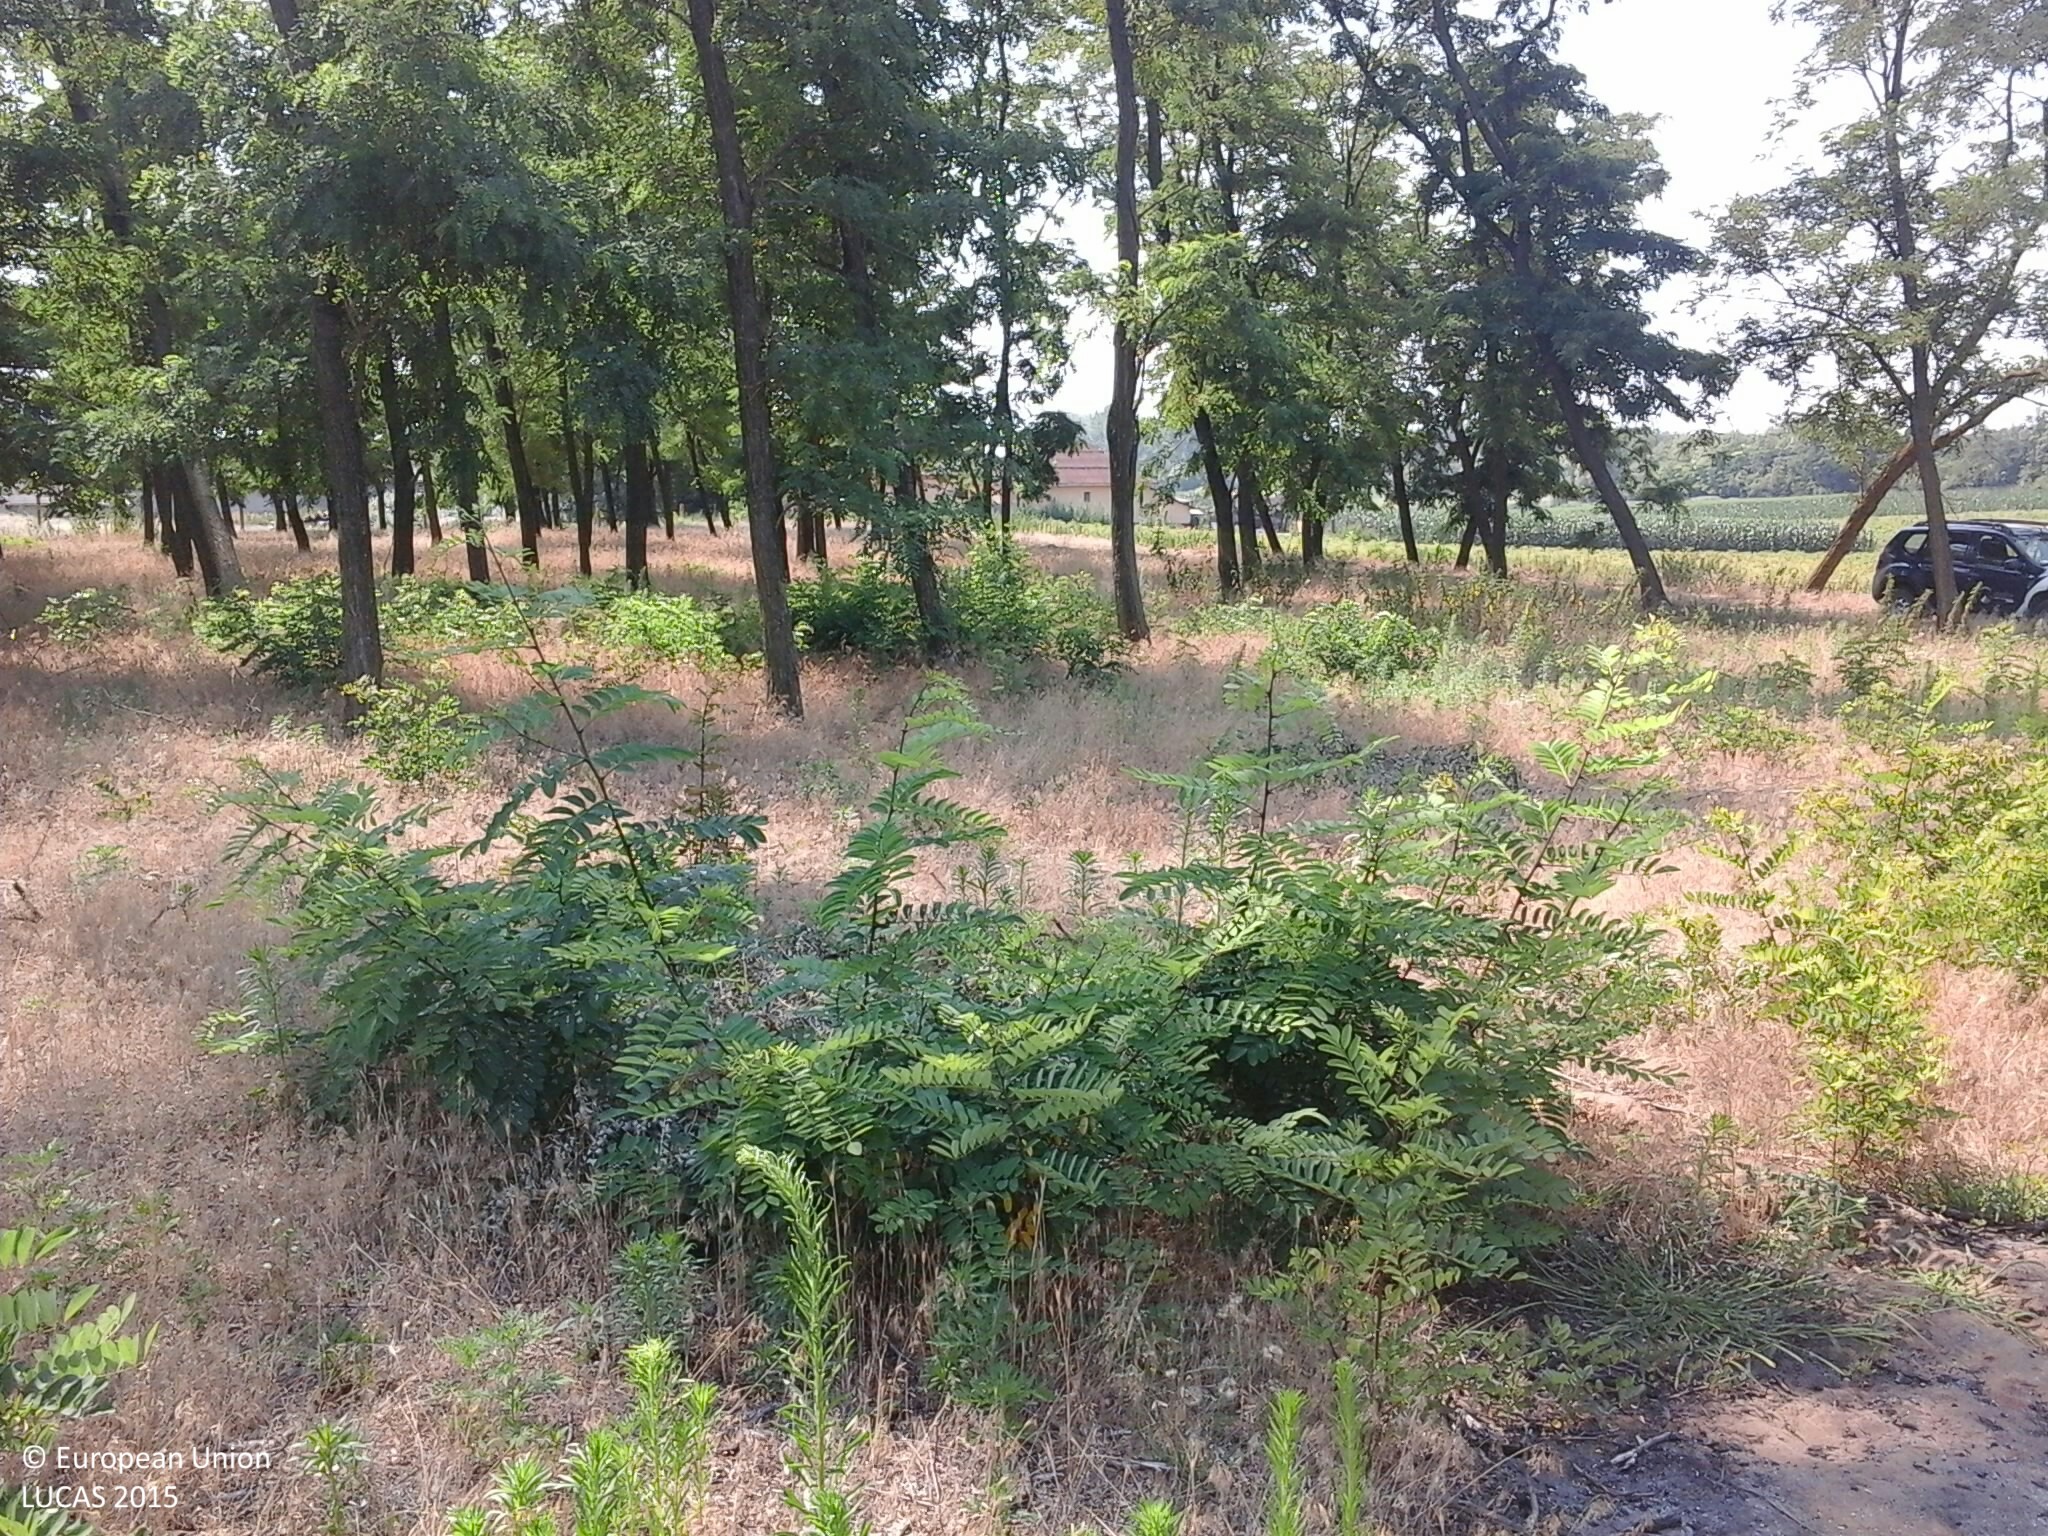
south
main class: Woodland
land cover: Broadleaved woodland
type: exotic forest
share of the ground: 10 - 25 %
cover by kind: herbaceous plants 85 %, broadleaved forest trees 15 %
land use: Semi-natural and natural areas not in use
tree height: < 5 m
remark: Nursery
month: July
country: HU
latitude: 47.8136
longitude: 22.0578
